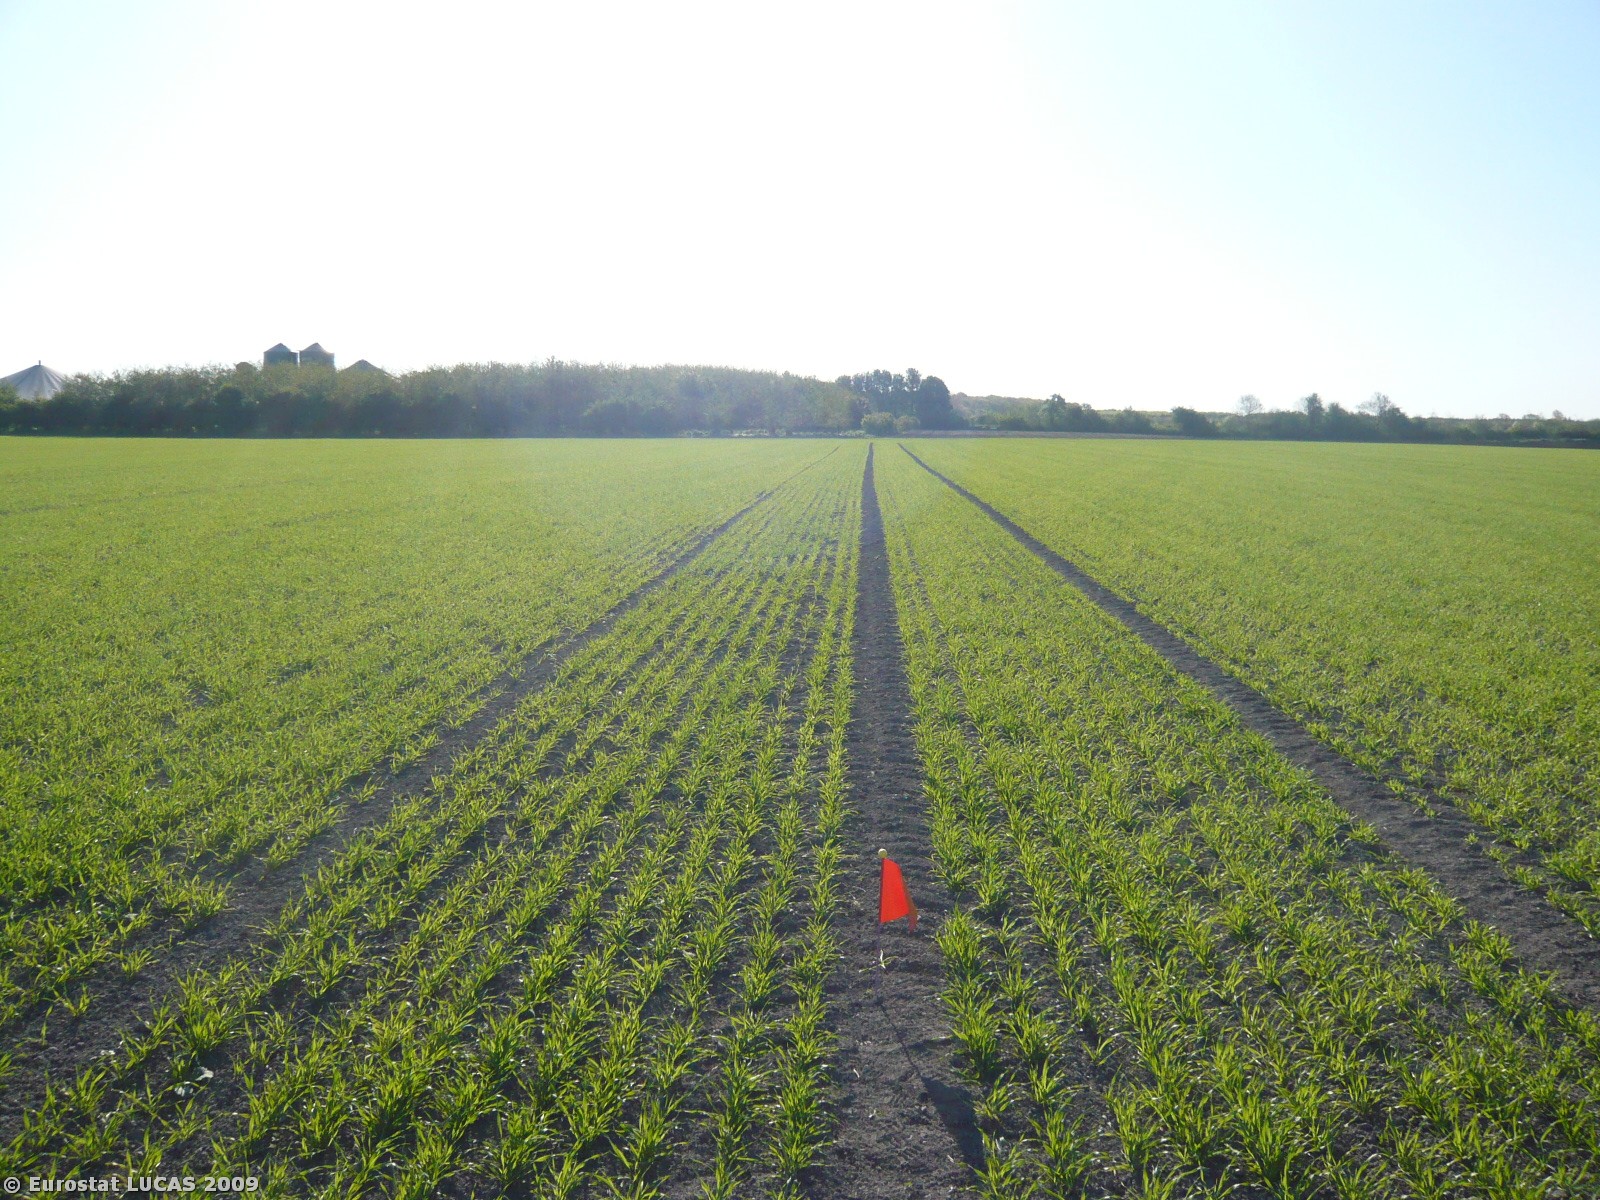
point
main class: Cropland
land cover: Common wheat
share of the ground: 25 - 50 %
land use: Agriculture (excluding fallow land and kitchen gardens)
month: May
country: DK
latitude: 55.0910
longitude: 12.1451
